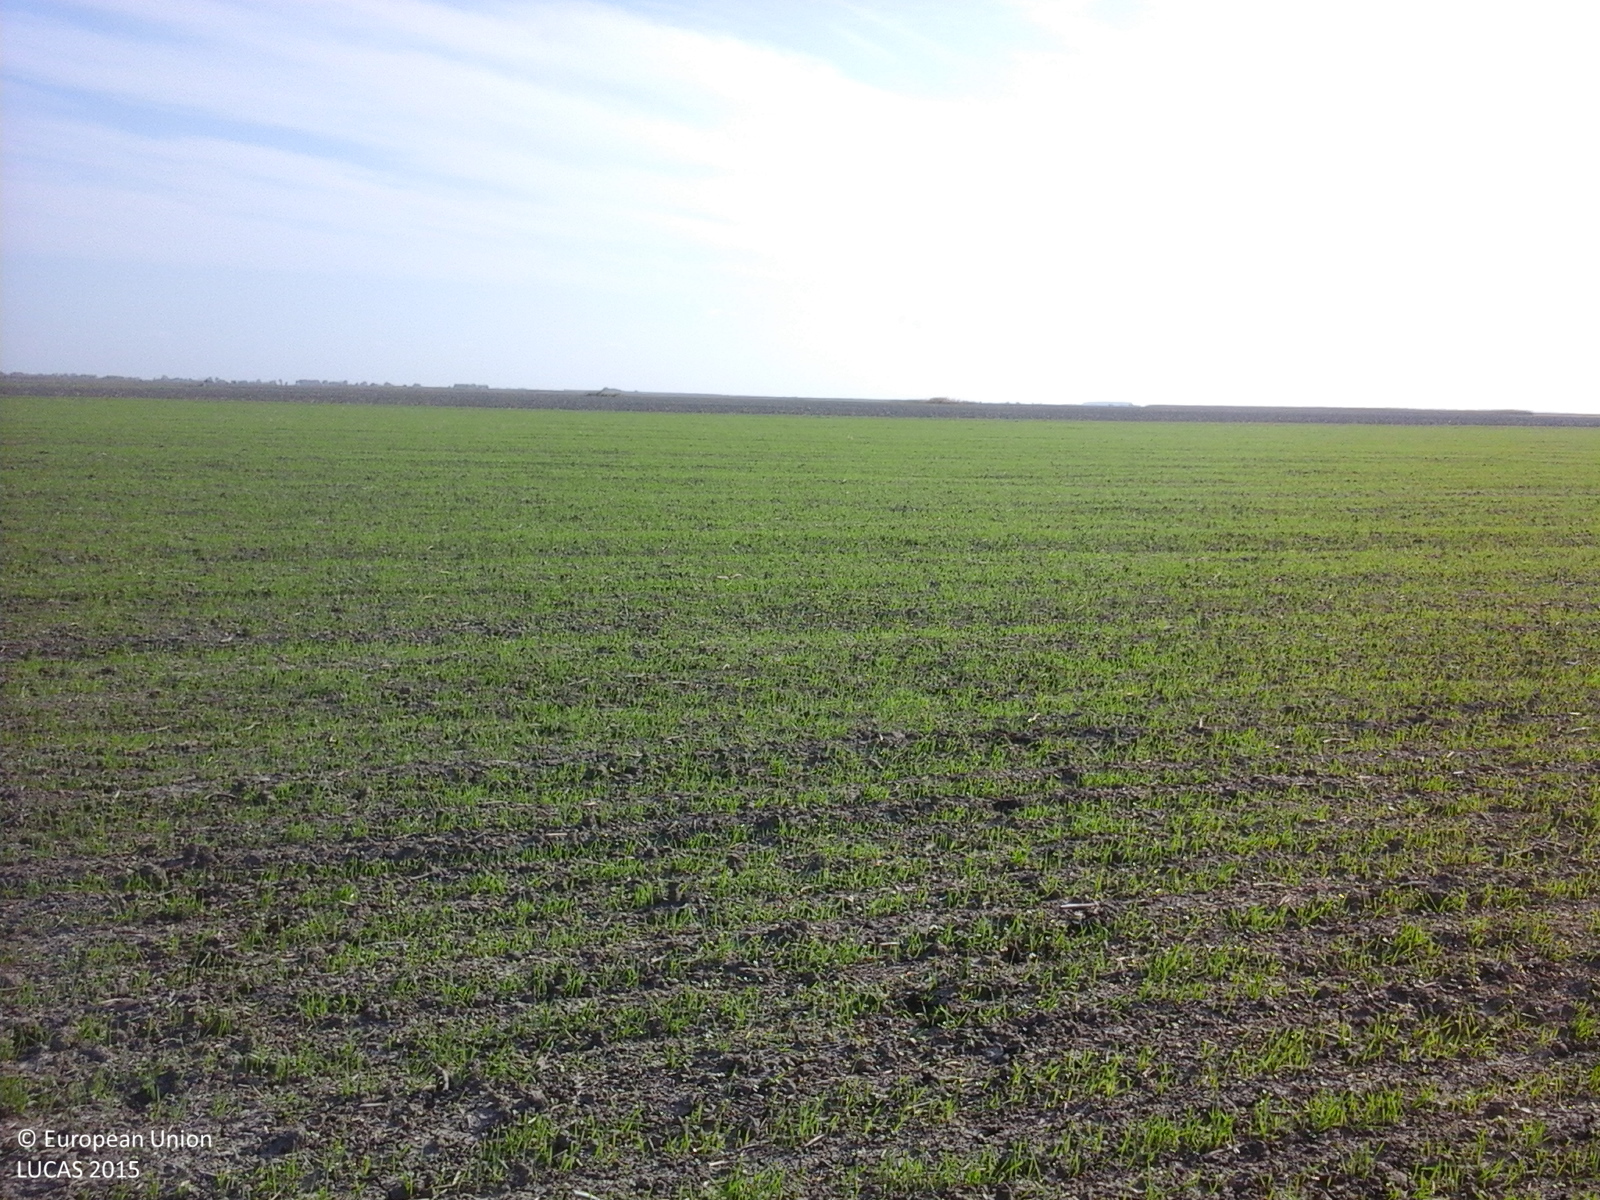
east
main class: Cropland
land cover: Common wheat
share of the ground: 25 - 50 %
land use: Agriculture (excluding fallow land and kitchen gardens)
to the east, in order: Common wheat; Other bare soil
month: October
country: RO
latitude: 45.4095
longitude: 27.2804
